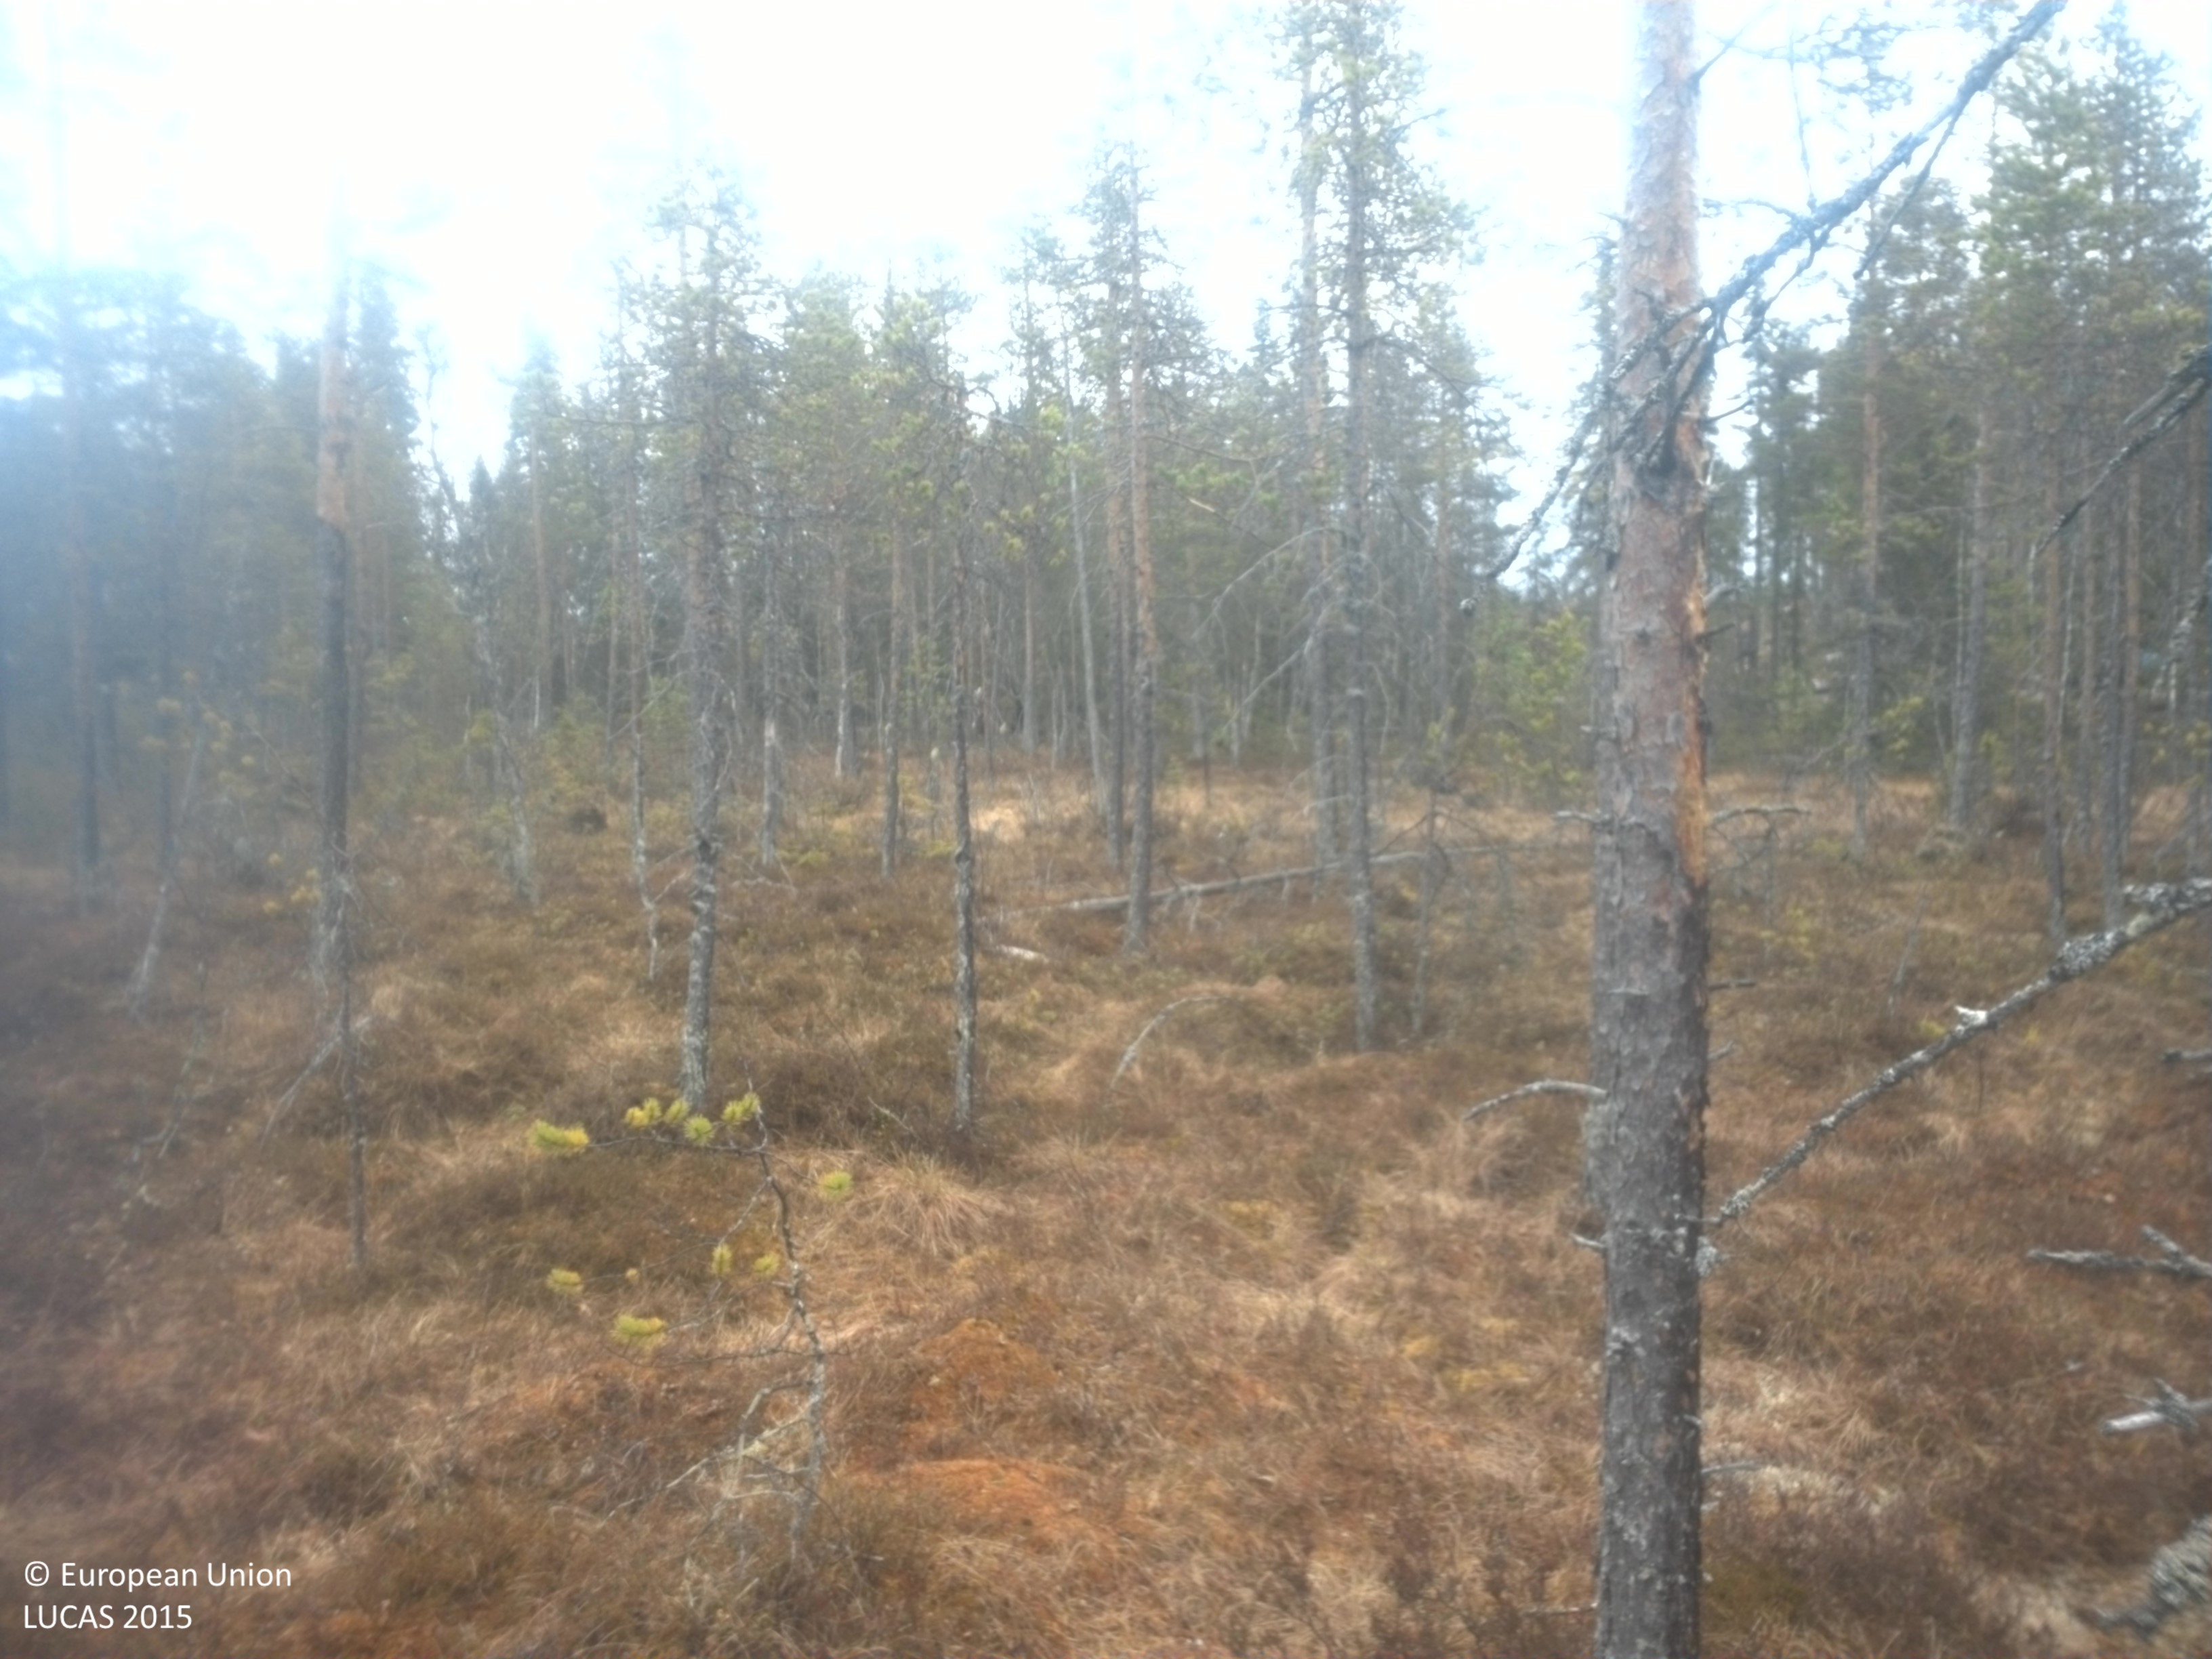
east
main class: Woodland
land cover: Pine dominated coniferous woodland
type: mire and swamp forests
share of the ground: 10 - 25 %
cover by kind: shrubs 40 %, lichens and mosses 30 %, coniferous forest trees 20 %, herbaceous plants 10 %
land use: Semi-natural and natural areas not in use
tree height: > 5 m
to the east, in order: Pine dominated coniferous woodland; Shrubland with sparse tree cover; Spontaneously vegetated surfaces; Ditches and canals; Tracks; Ditches and canals; Shrubland with sparse tree cover
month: May
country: SE
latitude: 62.6867
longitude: 15.1562
